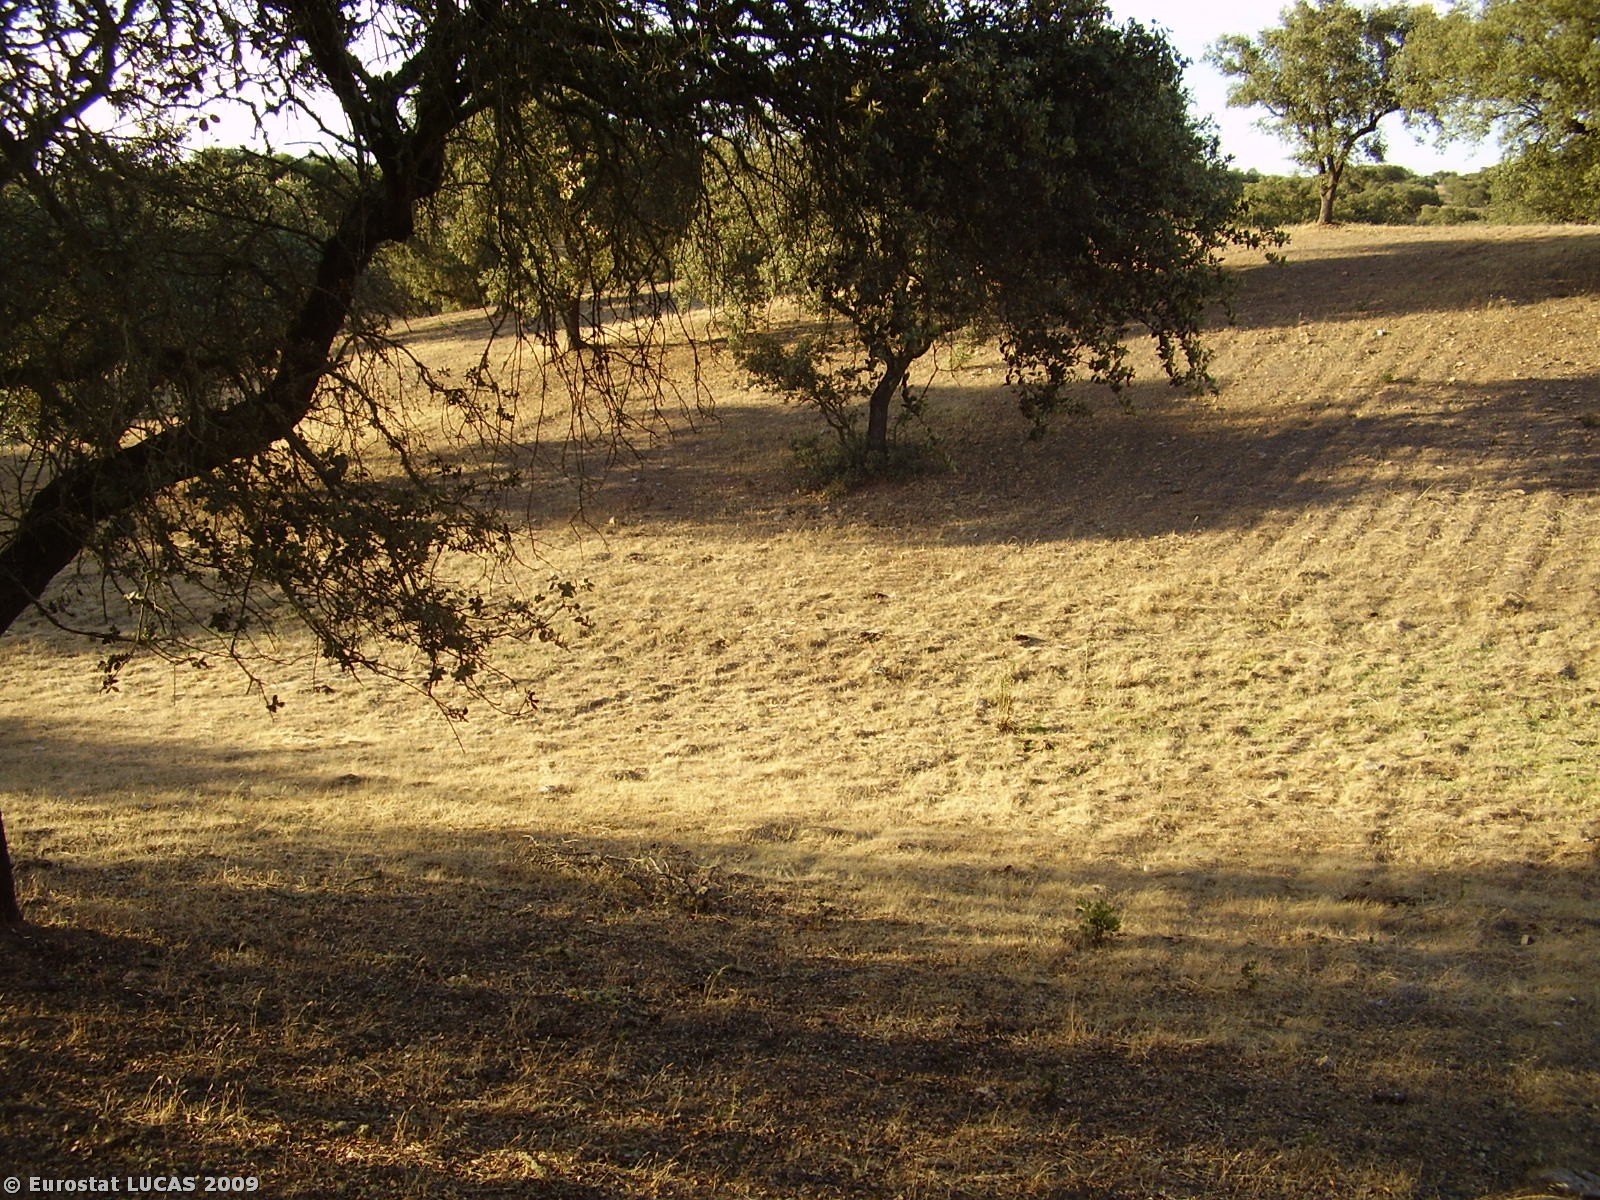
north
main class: Woodland
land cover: Broadleaved woodland
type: broadleaved evergreen forest
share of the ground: 10 - 25 %
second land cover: Spontaneously vegetated surfaces
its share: 10 - 25 %
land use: Forestry
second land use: Fallow land
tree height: > 5 m
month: July
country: PT
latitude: 38.4819
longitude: -7.6746
